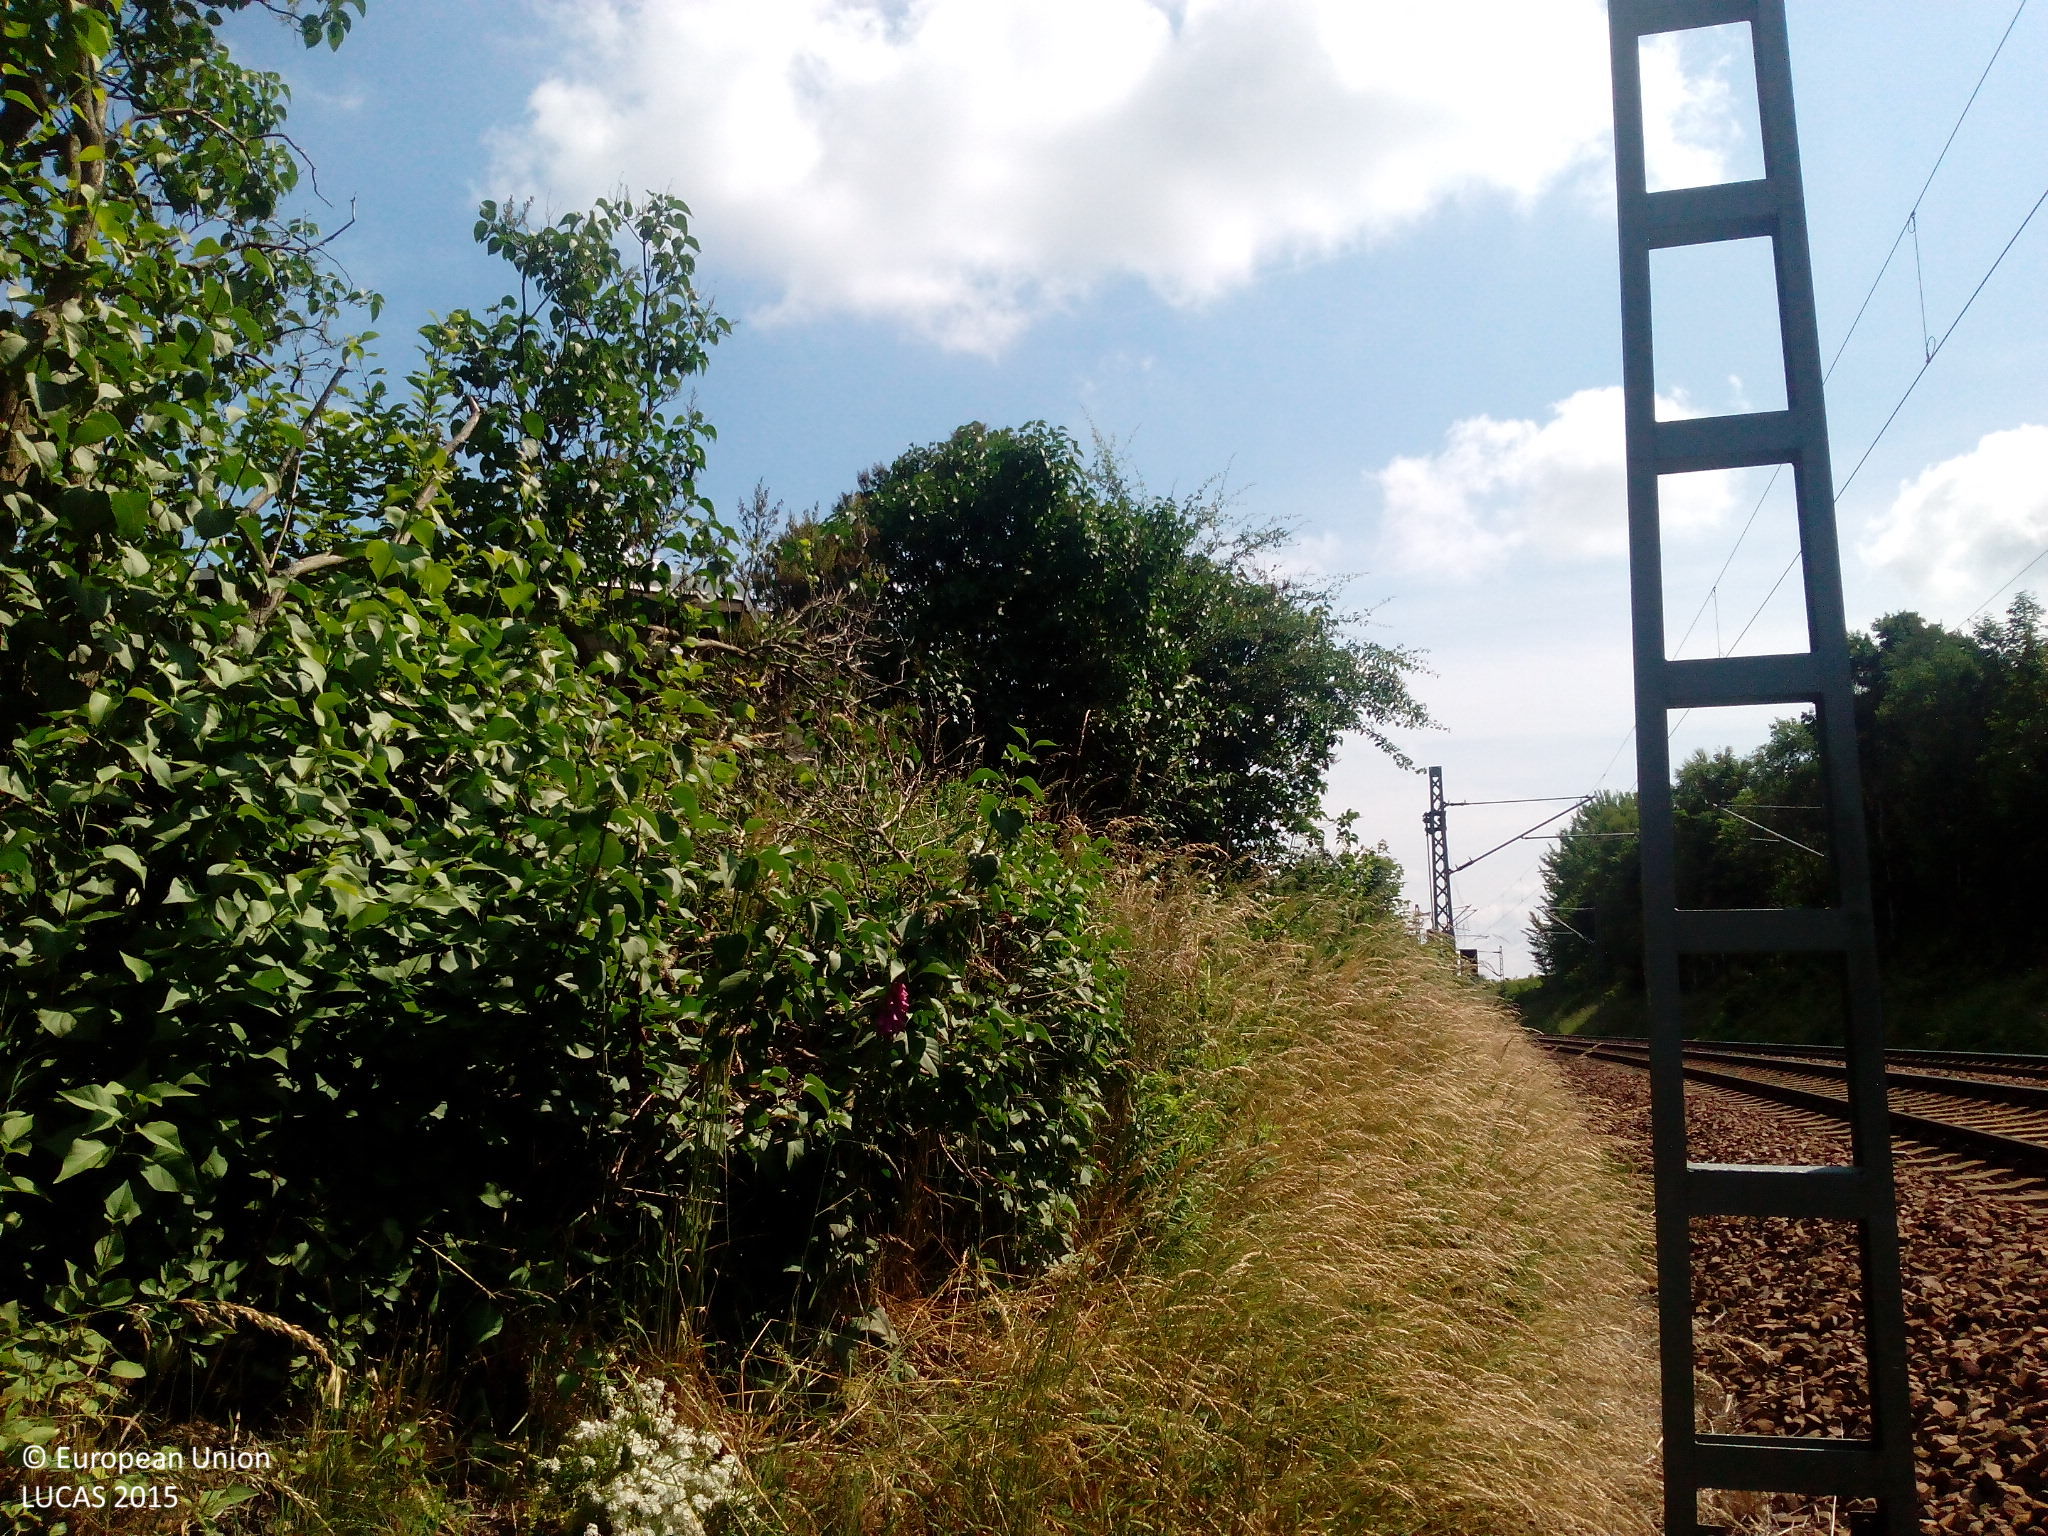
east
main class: Cropland
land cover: Floriculture and ornamental plants
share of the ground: > 75 %
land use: Kitchen garden
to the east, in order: Fences; Shrubland with sparse tree cover; Electric lines; Railways; Electric lines; Spruce dominated coniferous woodland; Shrubland without tree cover; Rape and turnip rape; Temporary grasslands
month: June
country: DE
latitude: 50.9074
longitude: 13.3992
